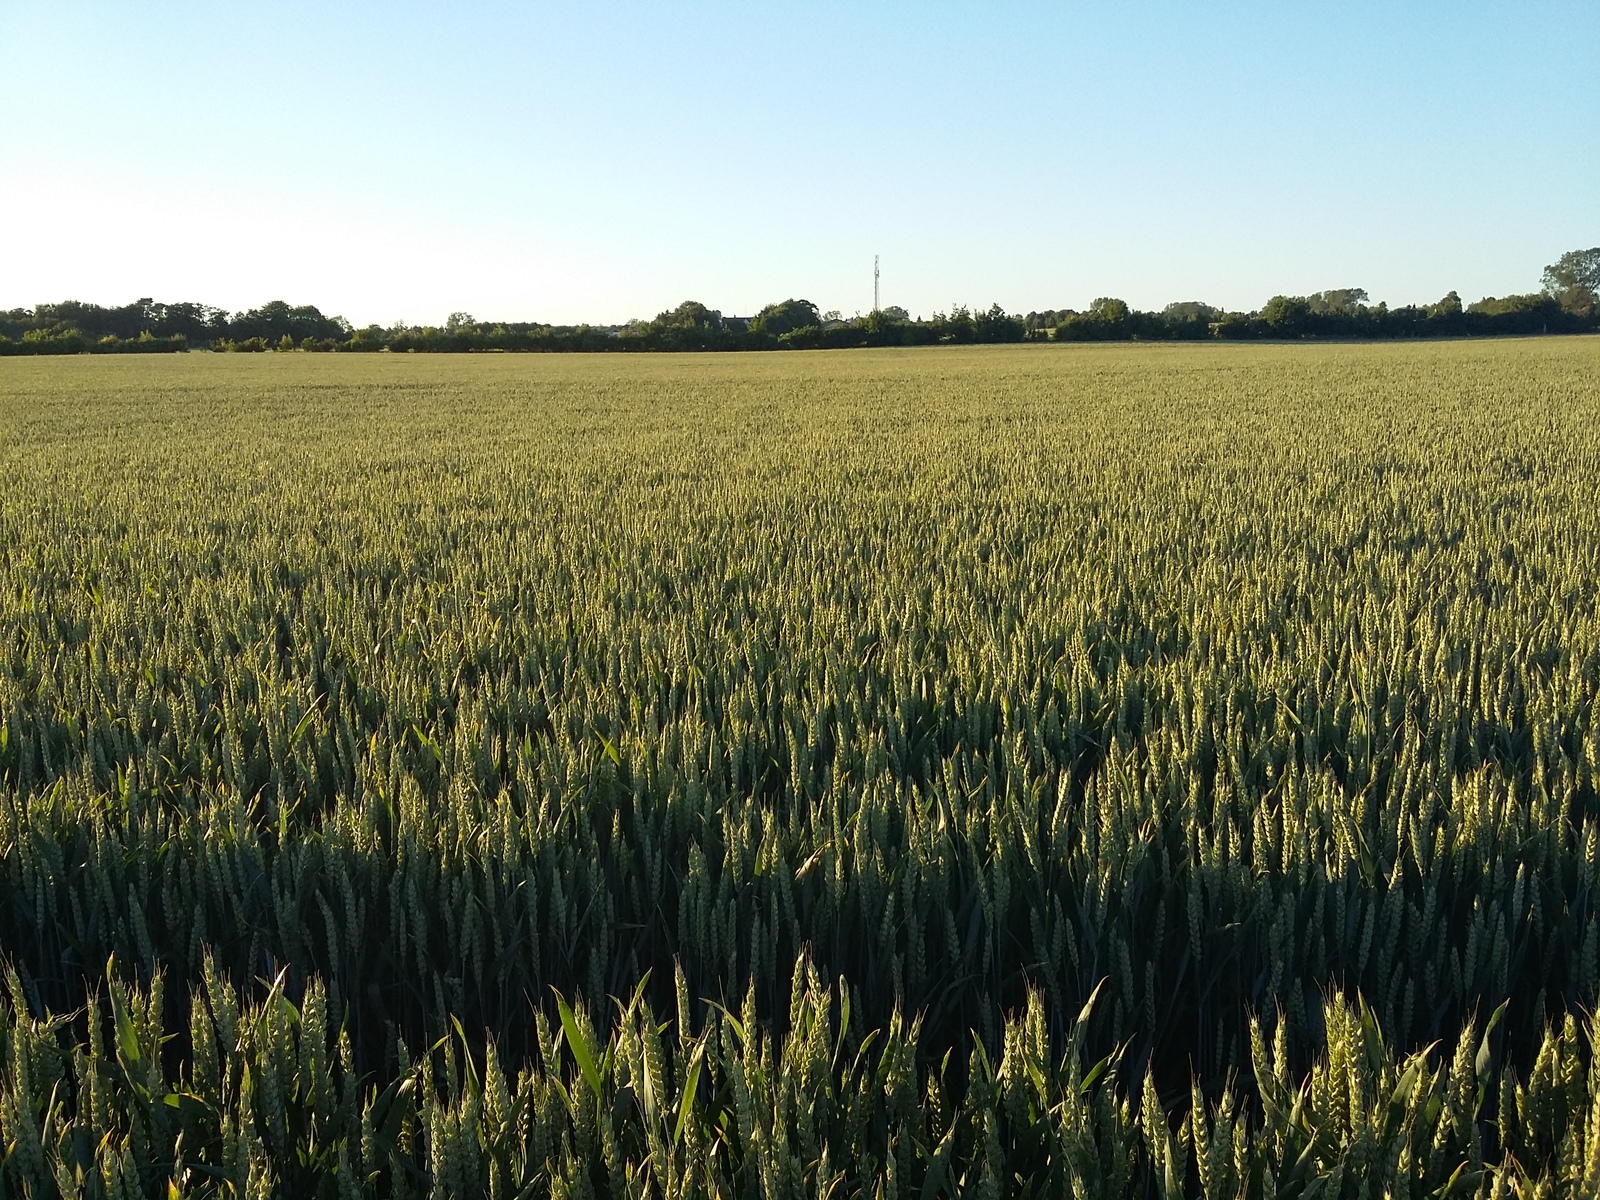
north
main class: Cropland
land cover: Common wheat
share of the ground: > 75 %
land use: Agriculture (excluding fallow land and kitchen gardens)
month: July
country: DK
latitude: 55.0910
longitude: 12.1451
